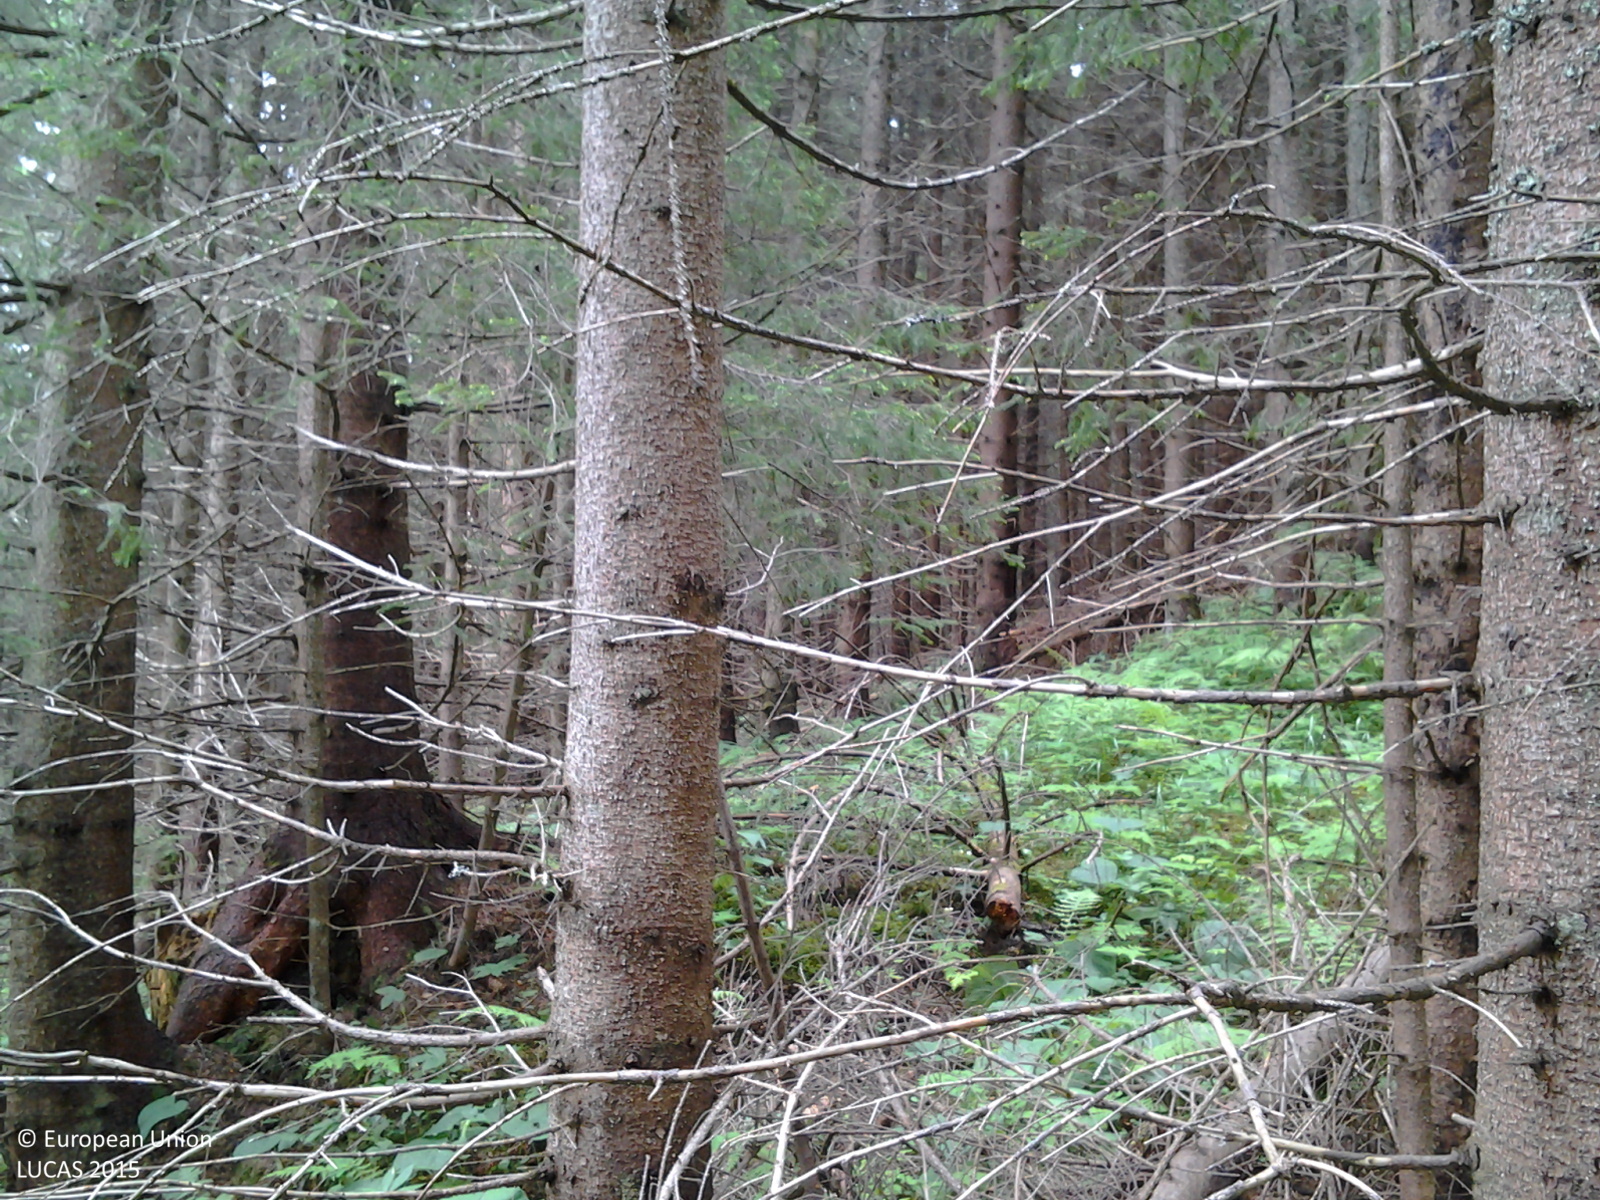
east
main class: Woodland
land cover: Spruce dominated coniferous woodland
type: alpine coniferous forest
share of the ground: > 75 %
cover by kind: coniferous forest trees 100 %
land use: Forestry
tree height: > 5 m
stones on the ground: < 10 %
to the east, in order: Spruce dominated coniferous woodland; Fences; Grassland with sparse tree/shrub cover; Spruce dominated coniferous woodland; Grassland with sparse tree/shrub cover; Rivers and streams; Grassland with sparse tree/shrub cover; Fences; Grassland with sparse tree/shrub cover; Fences; Grassland without tree/shrub cover
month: June
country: RO
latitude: 47.7026
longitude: 25.1275
